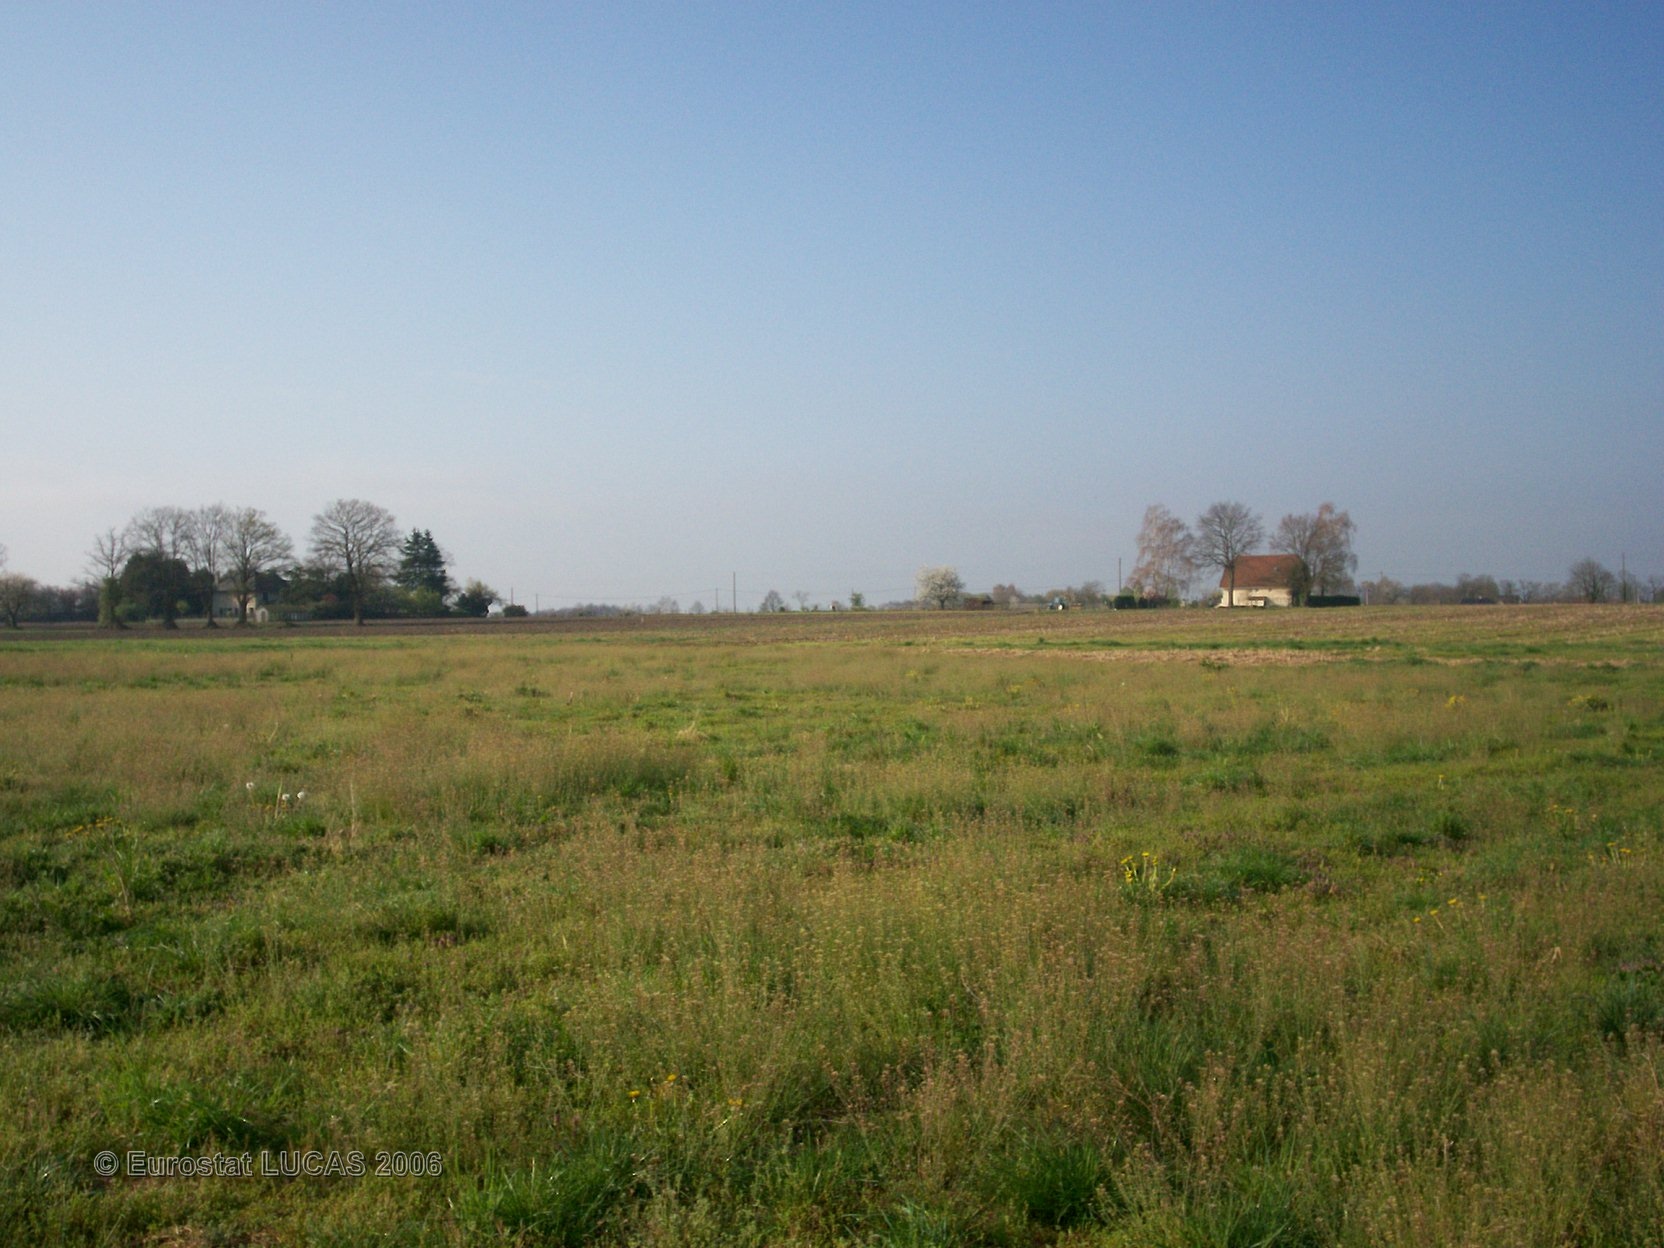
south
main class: Grassland
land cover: Grassland without tree/shrub cover
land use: Fallow land
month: April
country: FR
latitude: 43.2885
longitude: -0.1481
